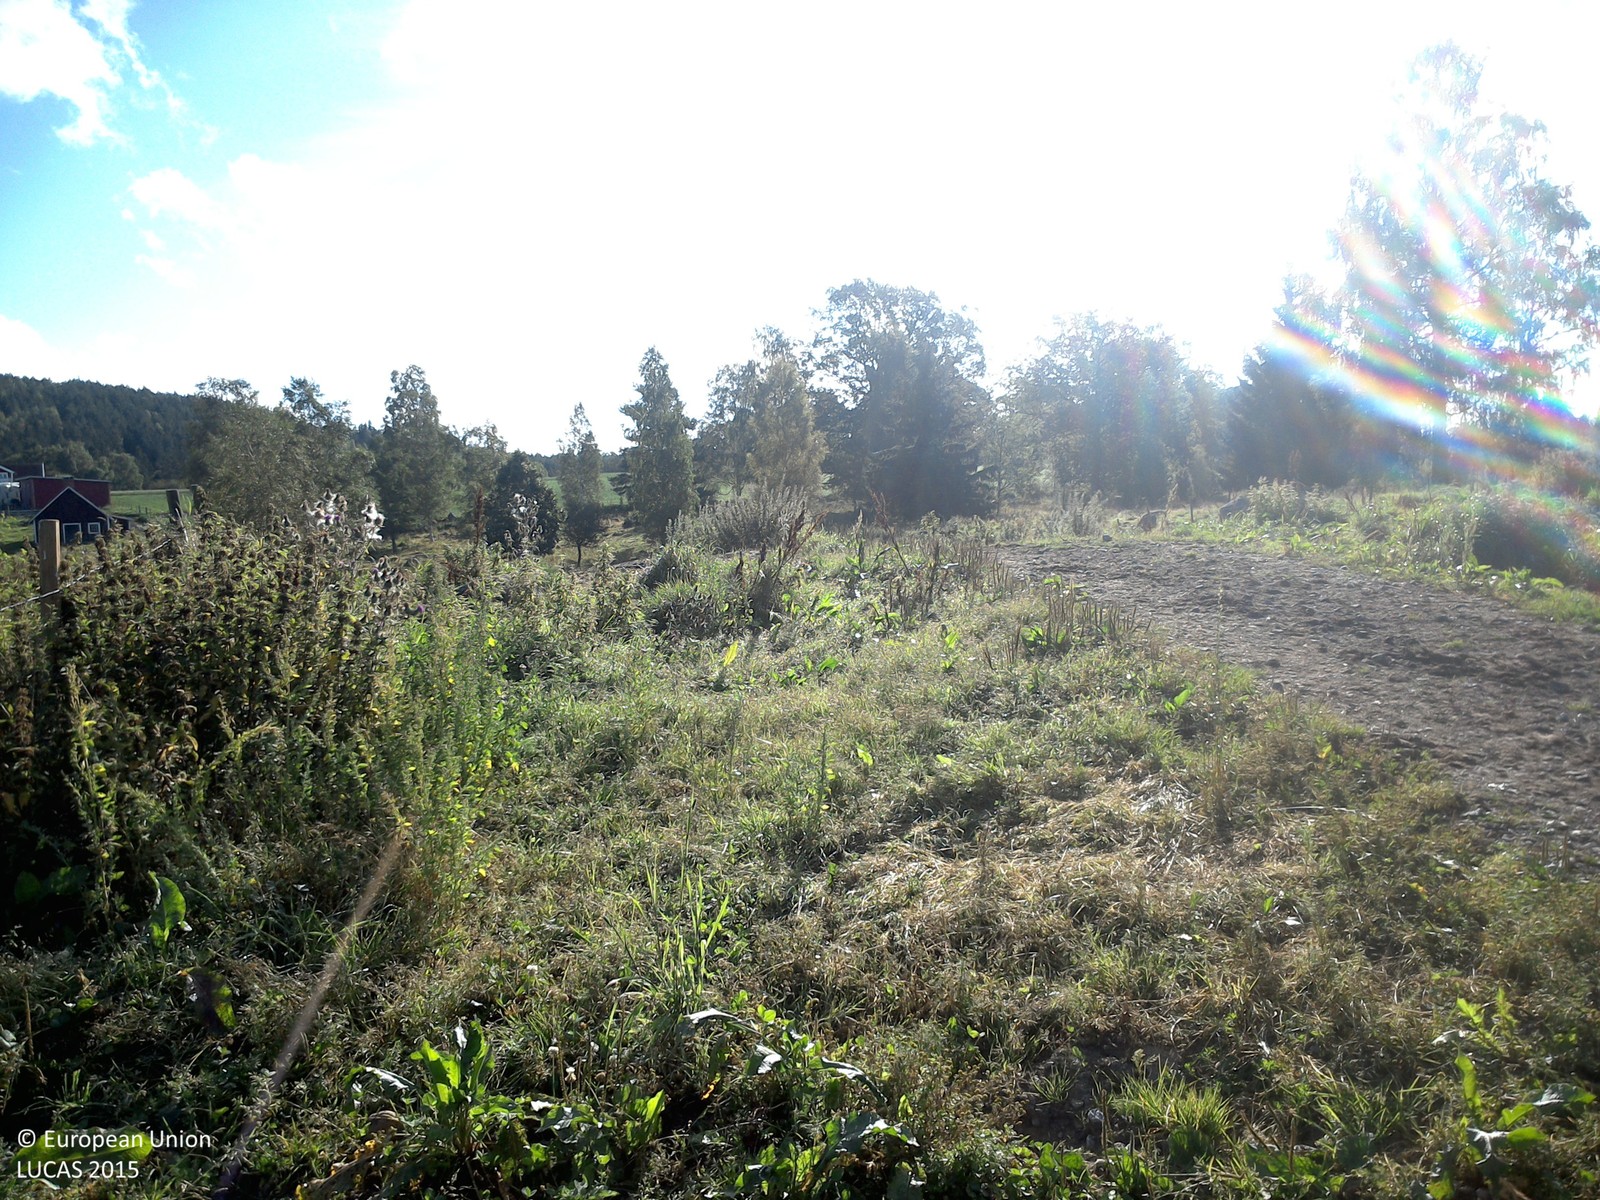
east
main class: Grassland
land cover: Grassland without tree/shrub cover
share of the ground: > 75 %
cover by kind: herbaceous plants 100 %
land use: Agriculture (excluding fallow land and kitchen gardens)
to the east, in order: Grassland without tree/shrub cover; Tracks; Fences; Grassland without tree/shrub cover; Tracks; Grassland without tree/shrub cover; Fences; Grassland with sparse tree/shrub cover; Fences; Grassland with sparse tree/shrub cover; Fences; Dry stone walls; Temporary grasslands
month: August
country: SE
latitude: 57.9176
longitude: 15.2790
